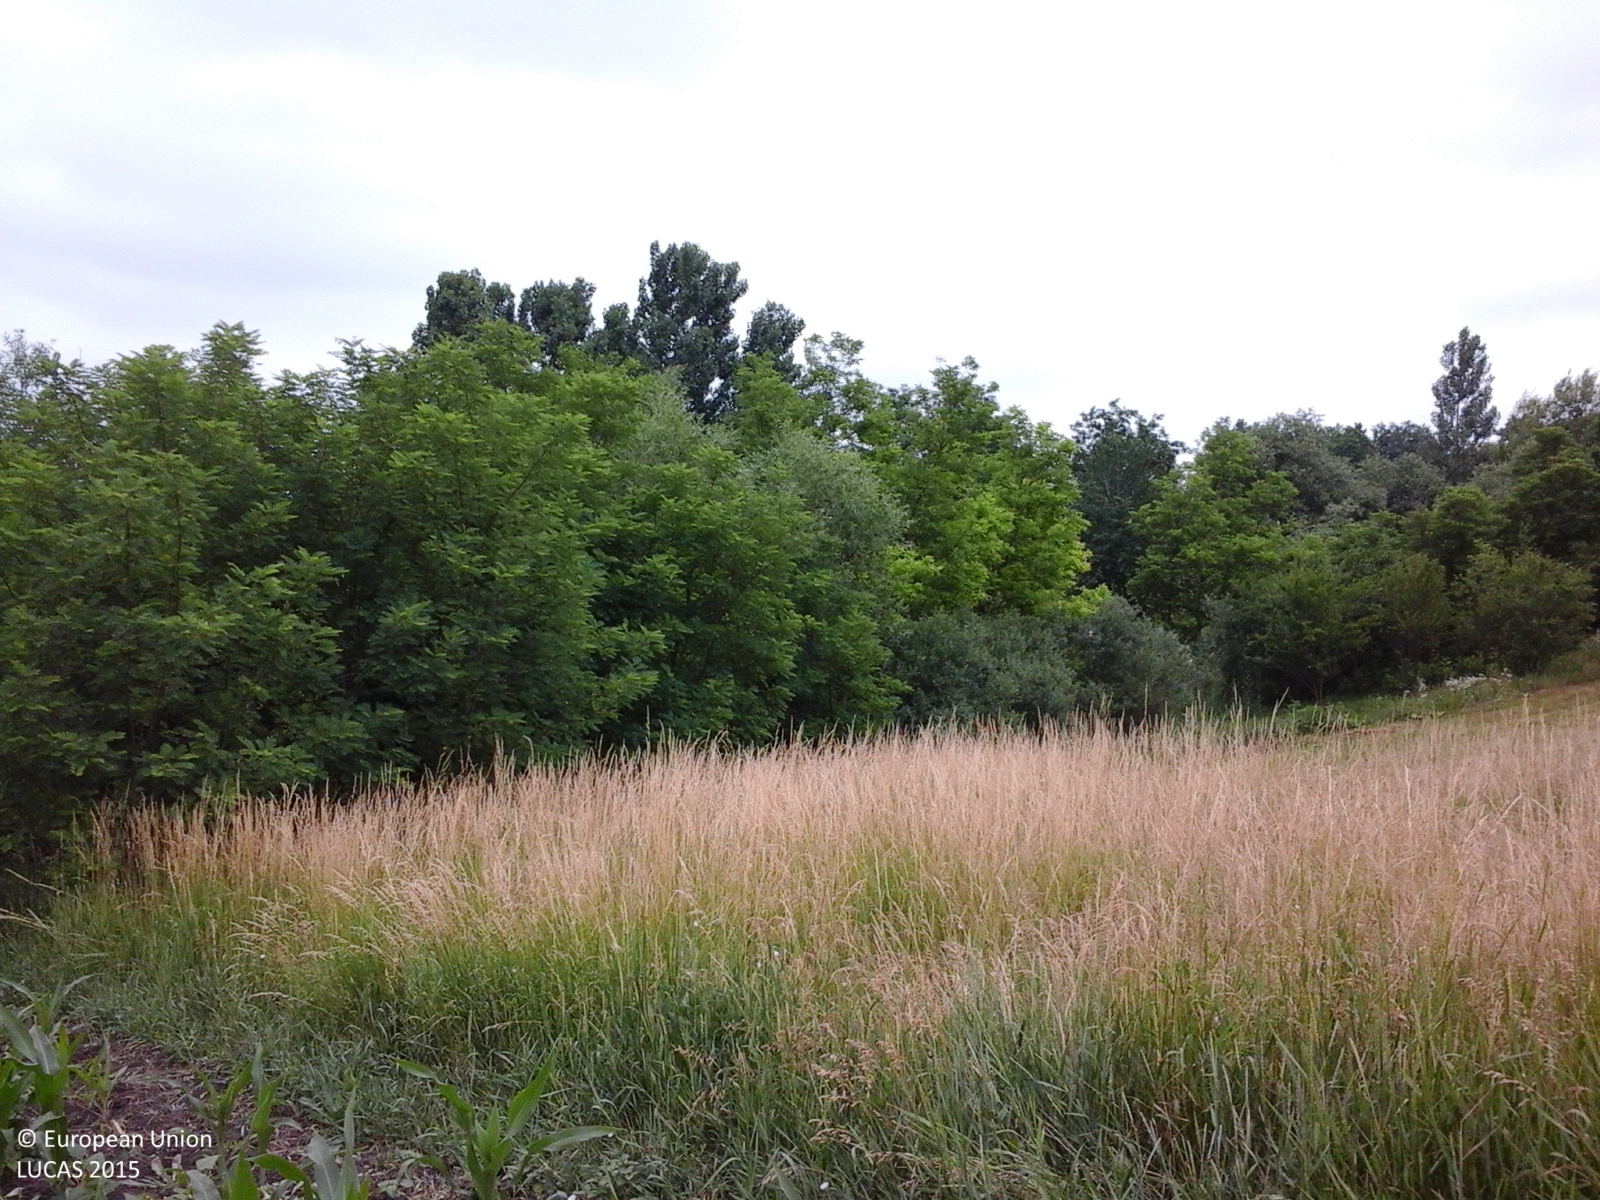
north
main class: Cropland
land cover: Maize
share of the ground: 25 - 50 %
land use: Agriculture (excluding fallow land and kitchen gardens)
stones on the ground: < 10 %
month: June
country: RO
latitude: 47.9608
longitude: 26.4975
